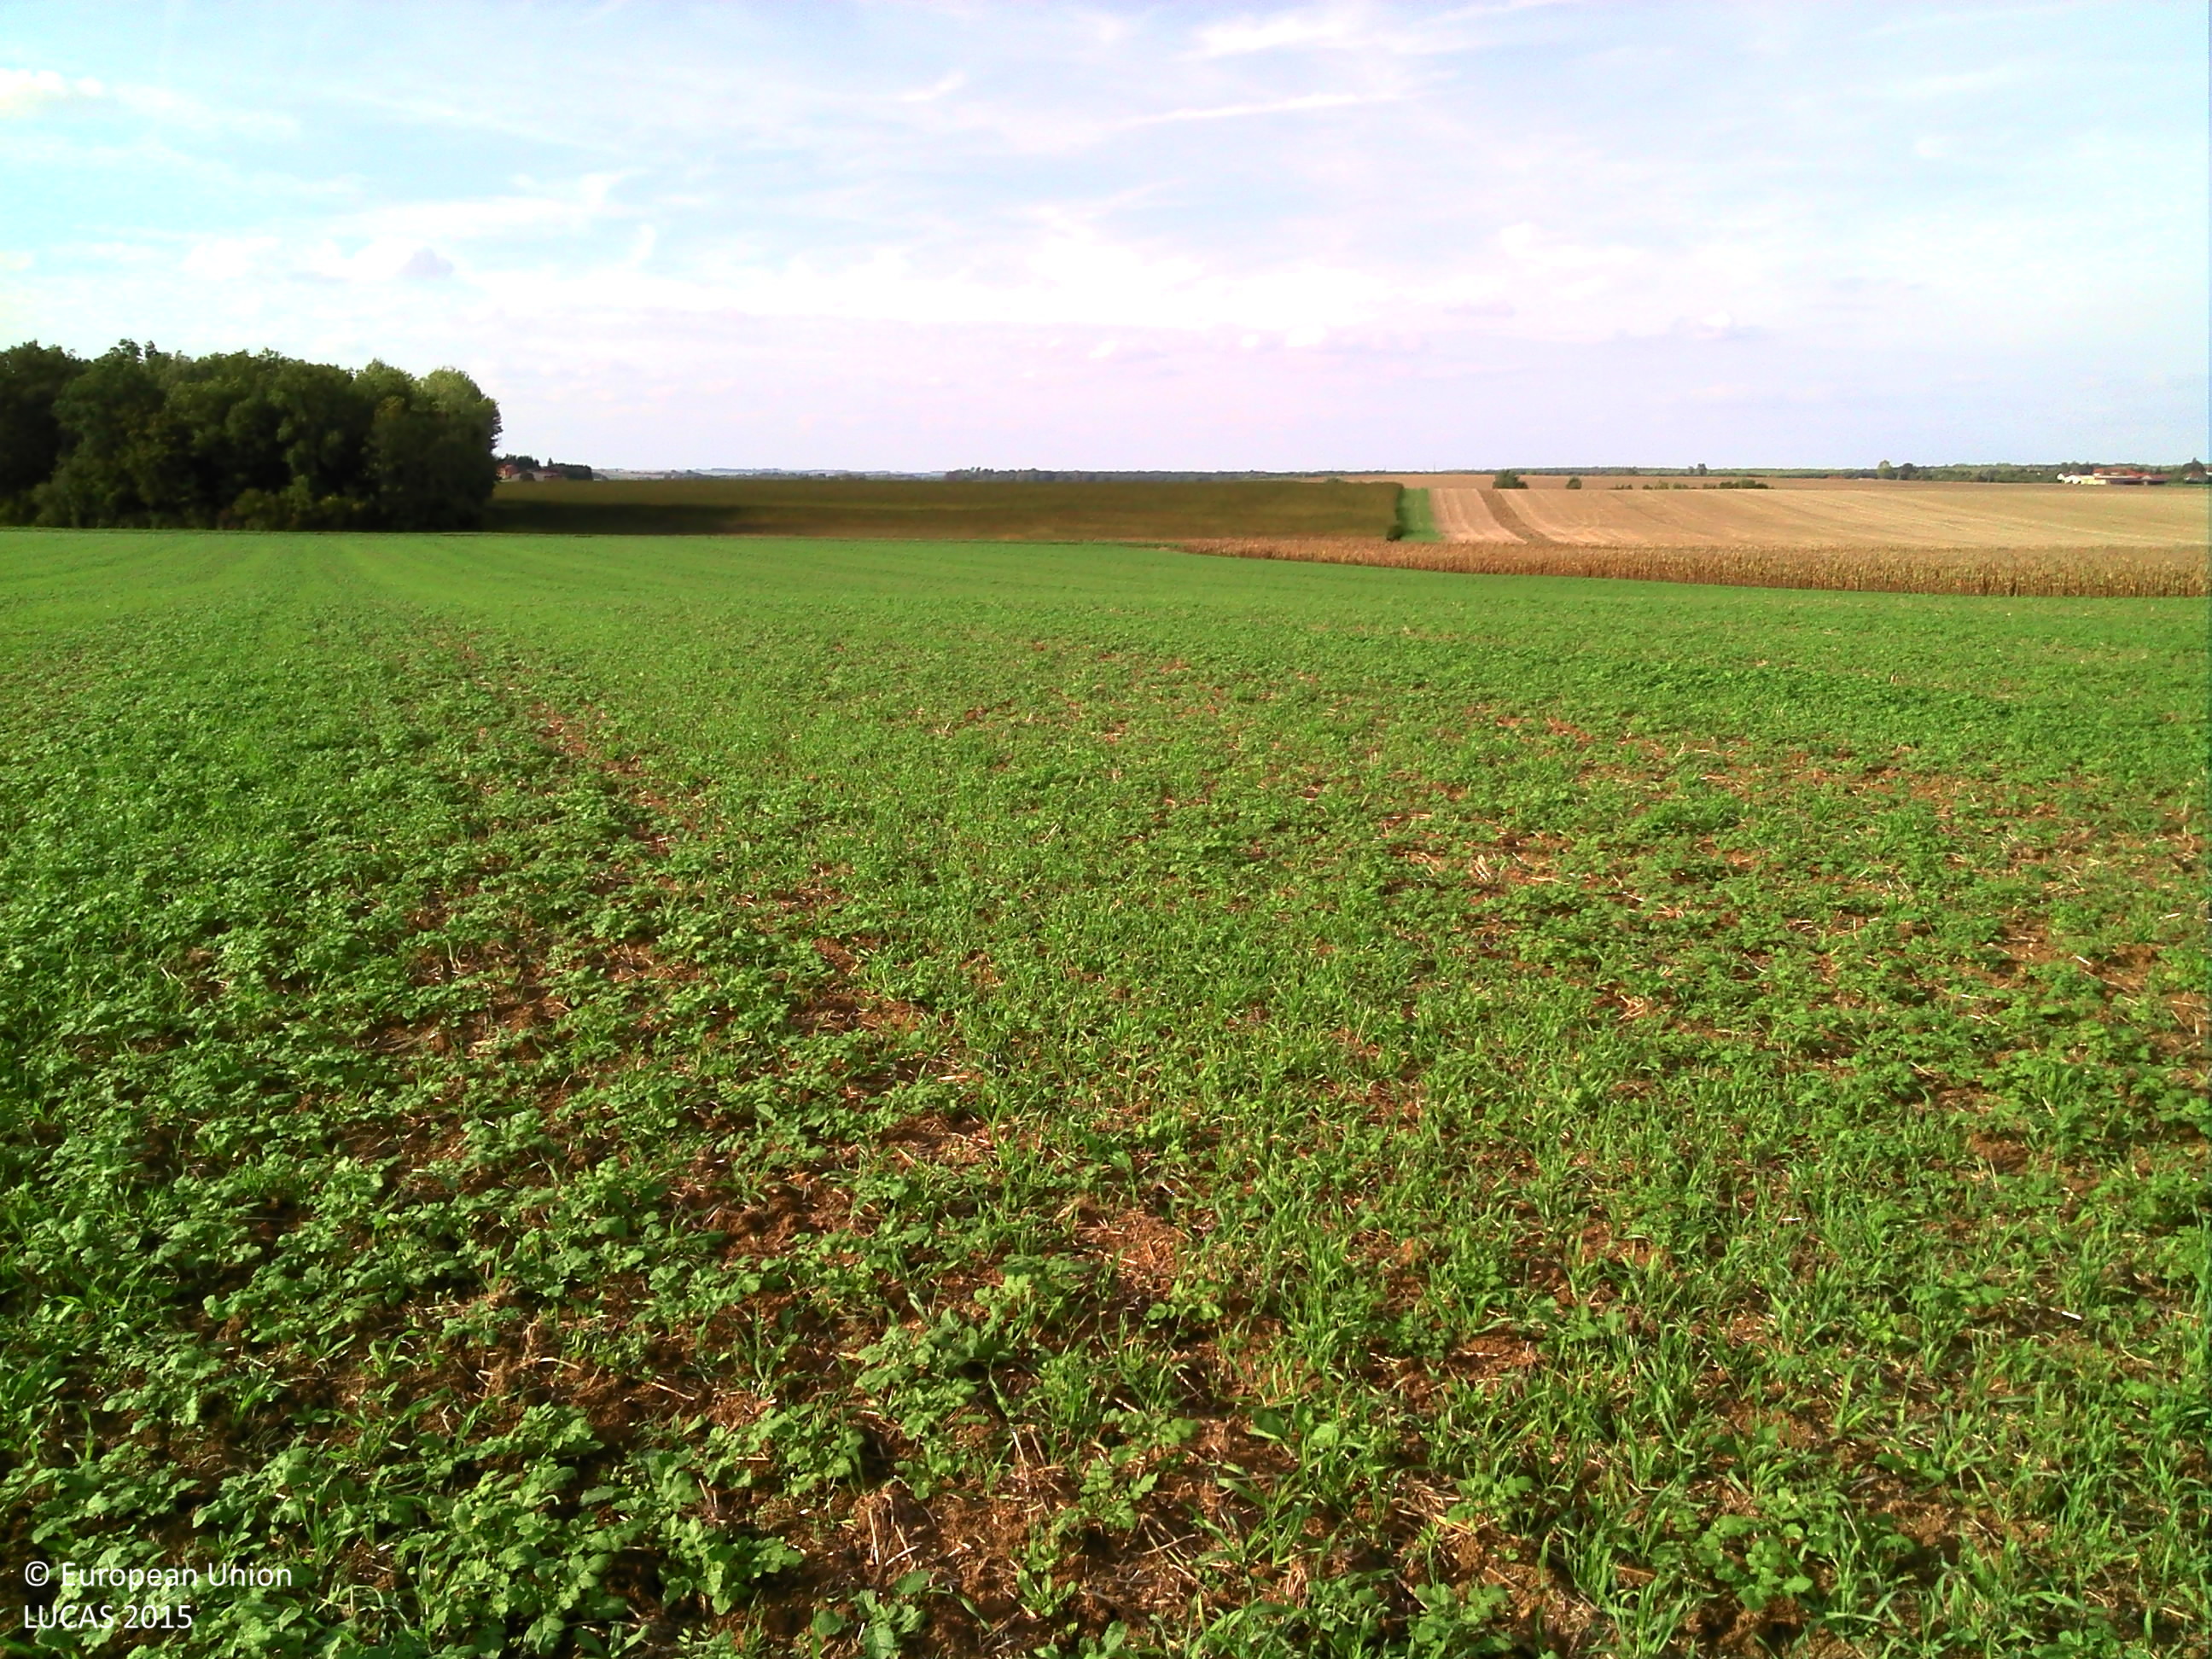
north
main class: Cropland
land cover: Other fibre and oleaginous crops
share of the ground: > 75 %
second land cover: Other leguminous and mixtures for fodder
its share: < 10 %
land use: Agriculture (excluding fallow land and kitchen gardens)
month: September
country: FR
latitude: 48.5238
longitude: 4.5950
